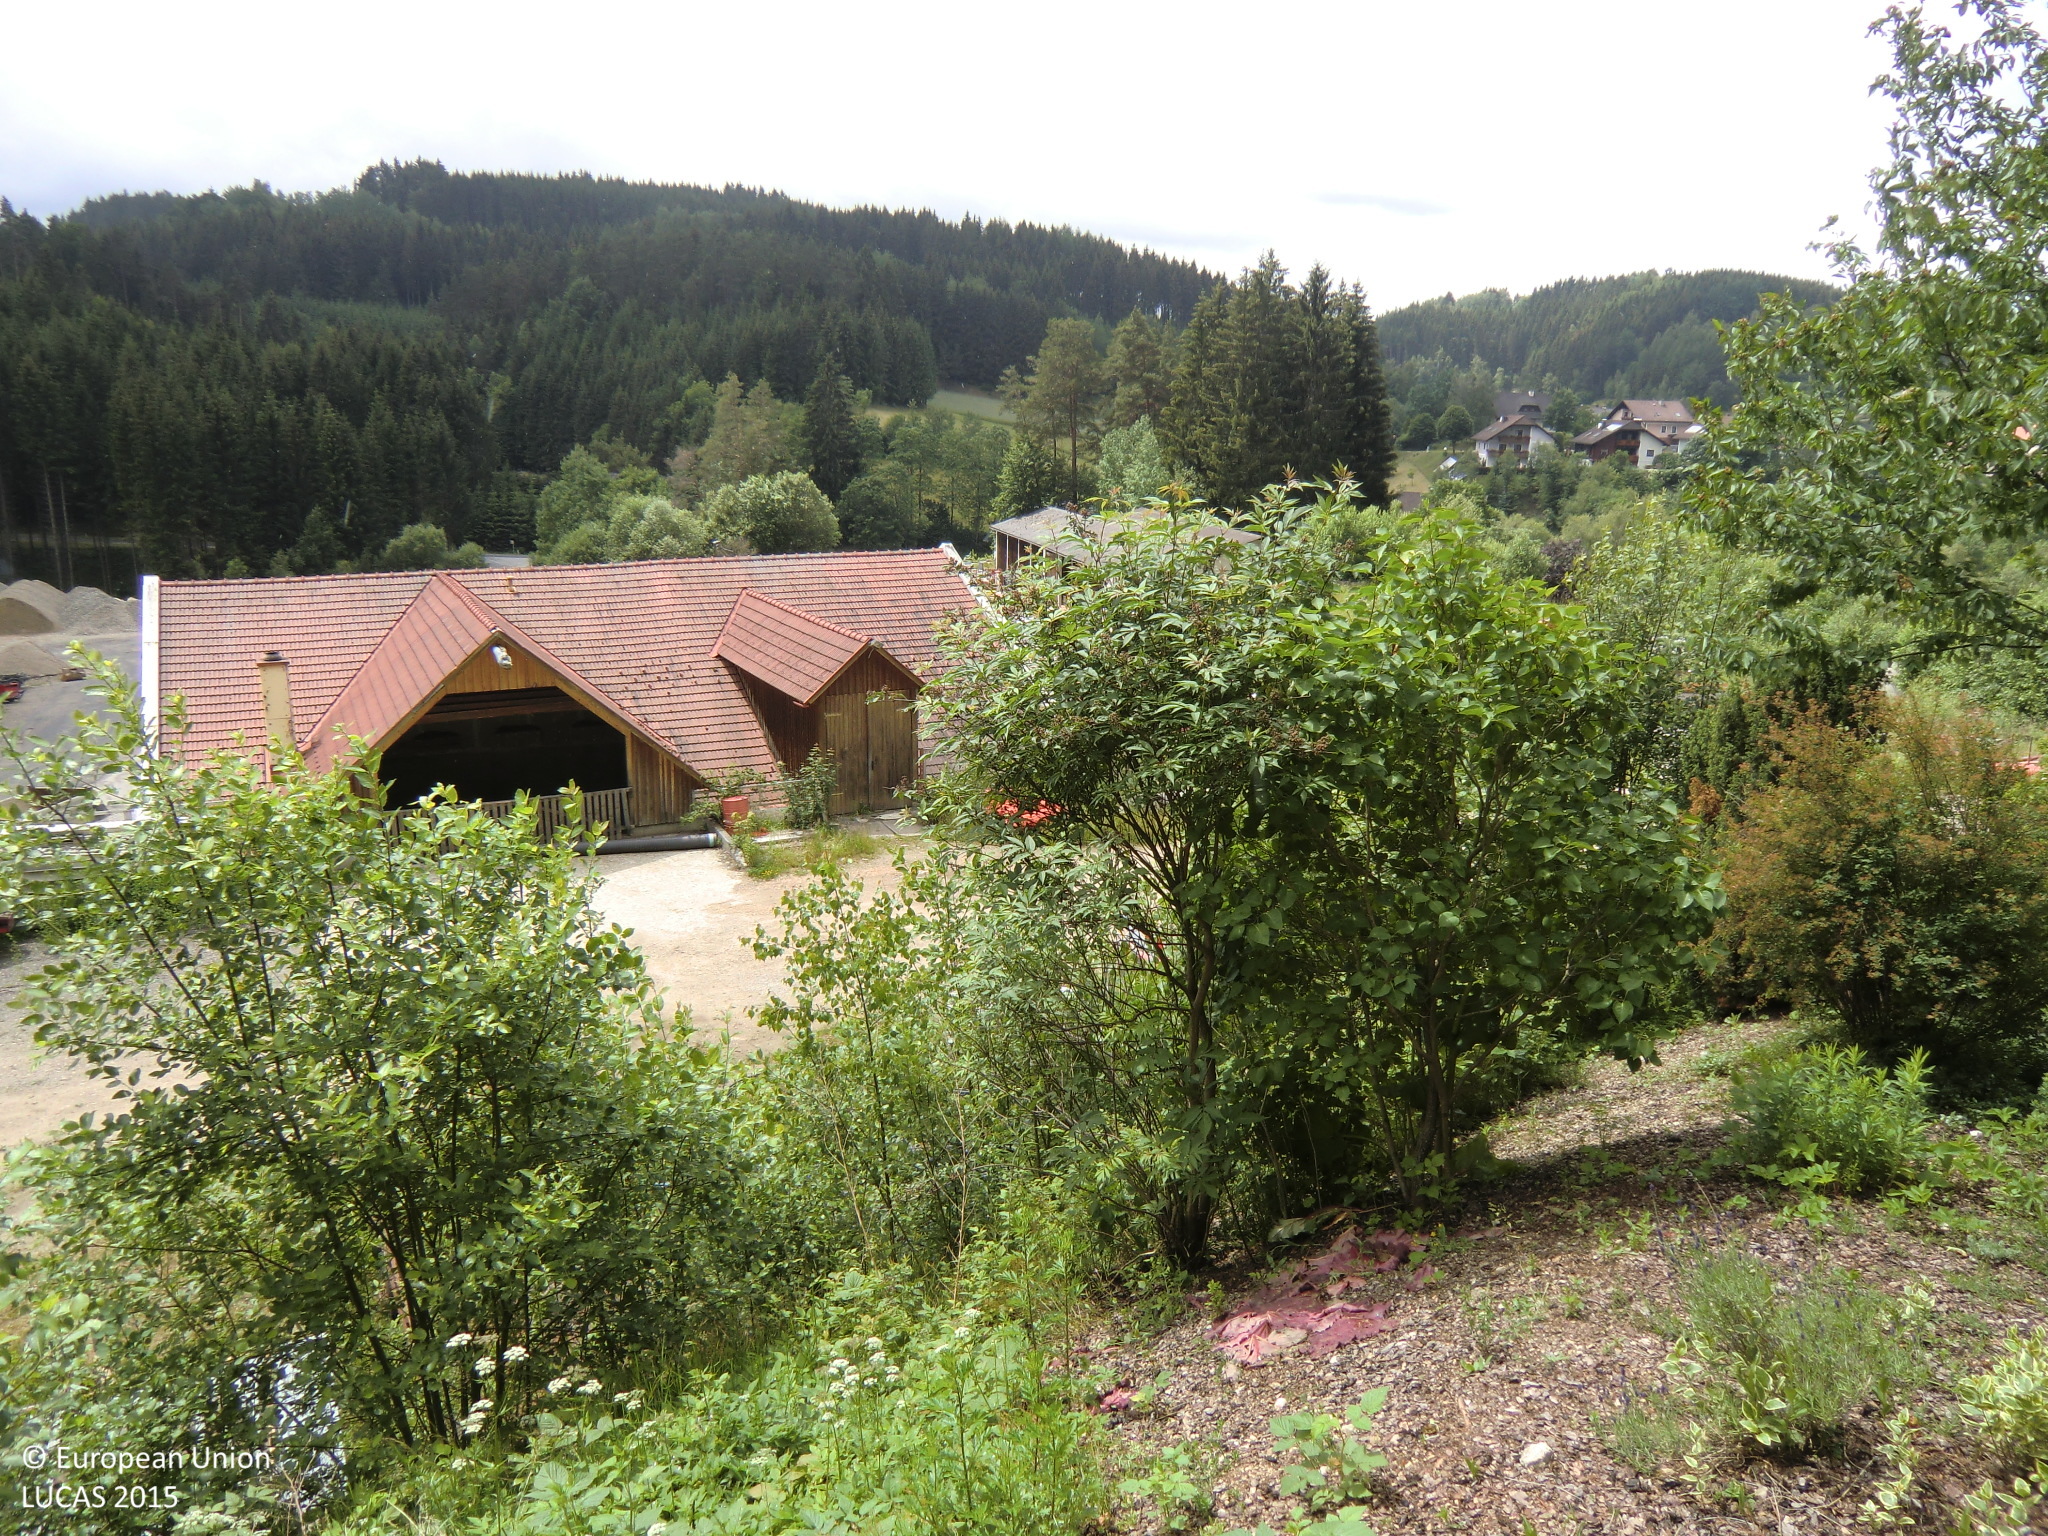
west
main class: Woodland
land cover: Broadleaved woodland
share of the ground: 50 - 75 %
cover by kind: broadleaved forest trees 65 %, herbaceous plants 25 %, unconsolidated bare surface 10 %
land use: Semi-natural and natural areas not in use
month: June
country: AT
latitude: 48.4506
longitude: 15.0448
